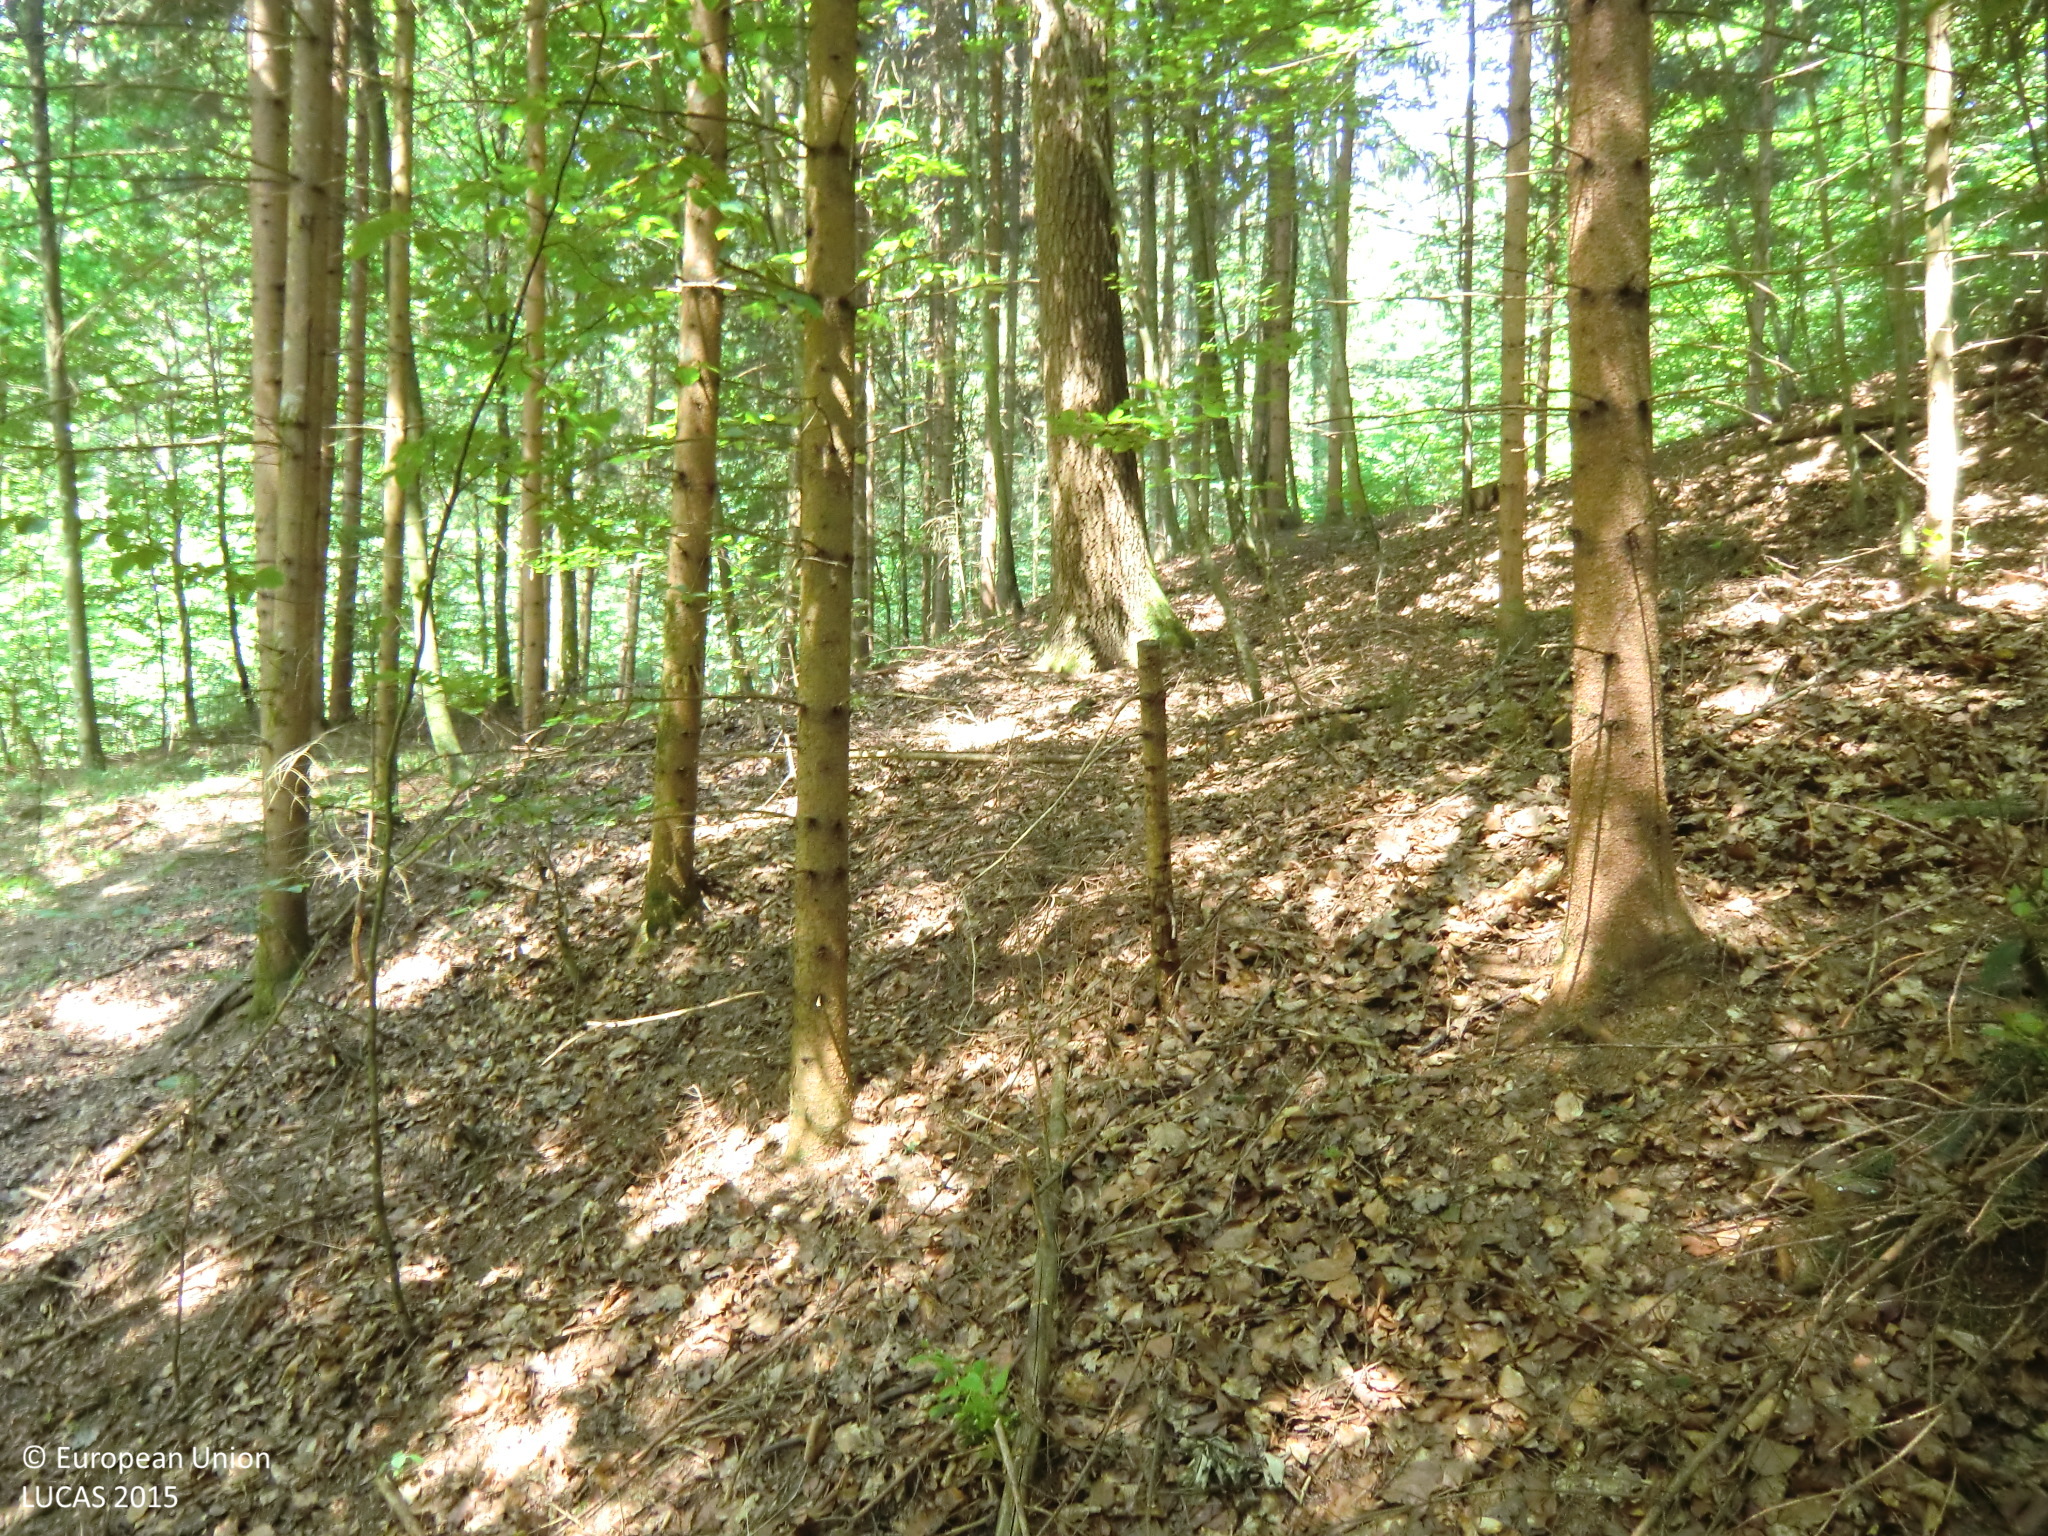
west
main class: Woodland
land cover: Spruce dominated mixed woodland
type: hemiboreal forest and nemoral coniferous forest and mixed broadleaved-coniferous forest
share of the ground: > 75 %
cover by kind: coniferous forest trees 45 %, broadleaved forest trees 45 %, unconsolidated bare surface 10 %
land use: Forestry
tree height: > 5 m
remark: Harvested field
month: July
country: AT
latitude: 47.1360
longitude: 15.7360
